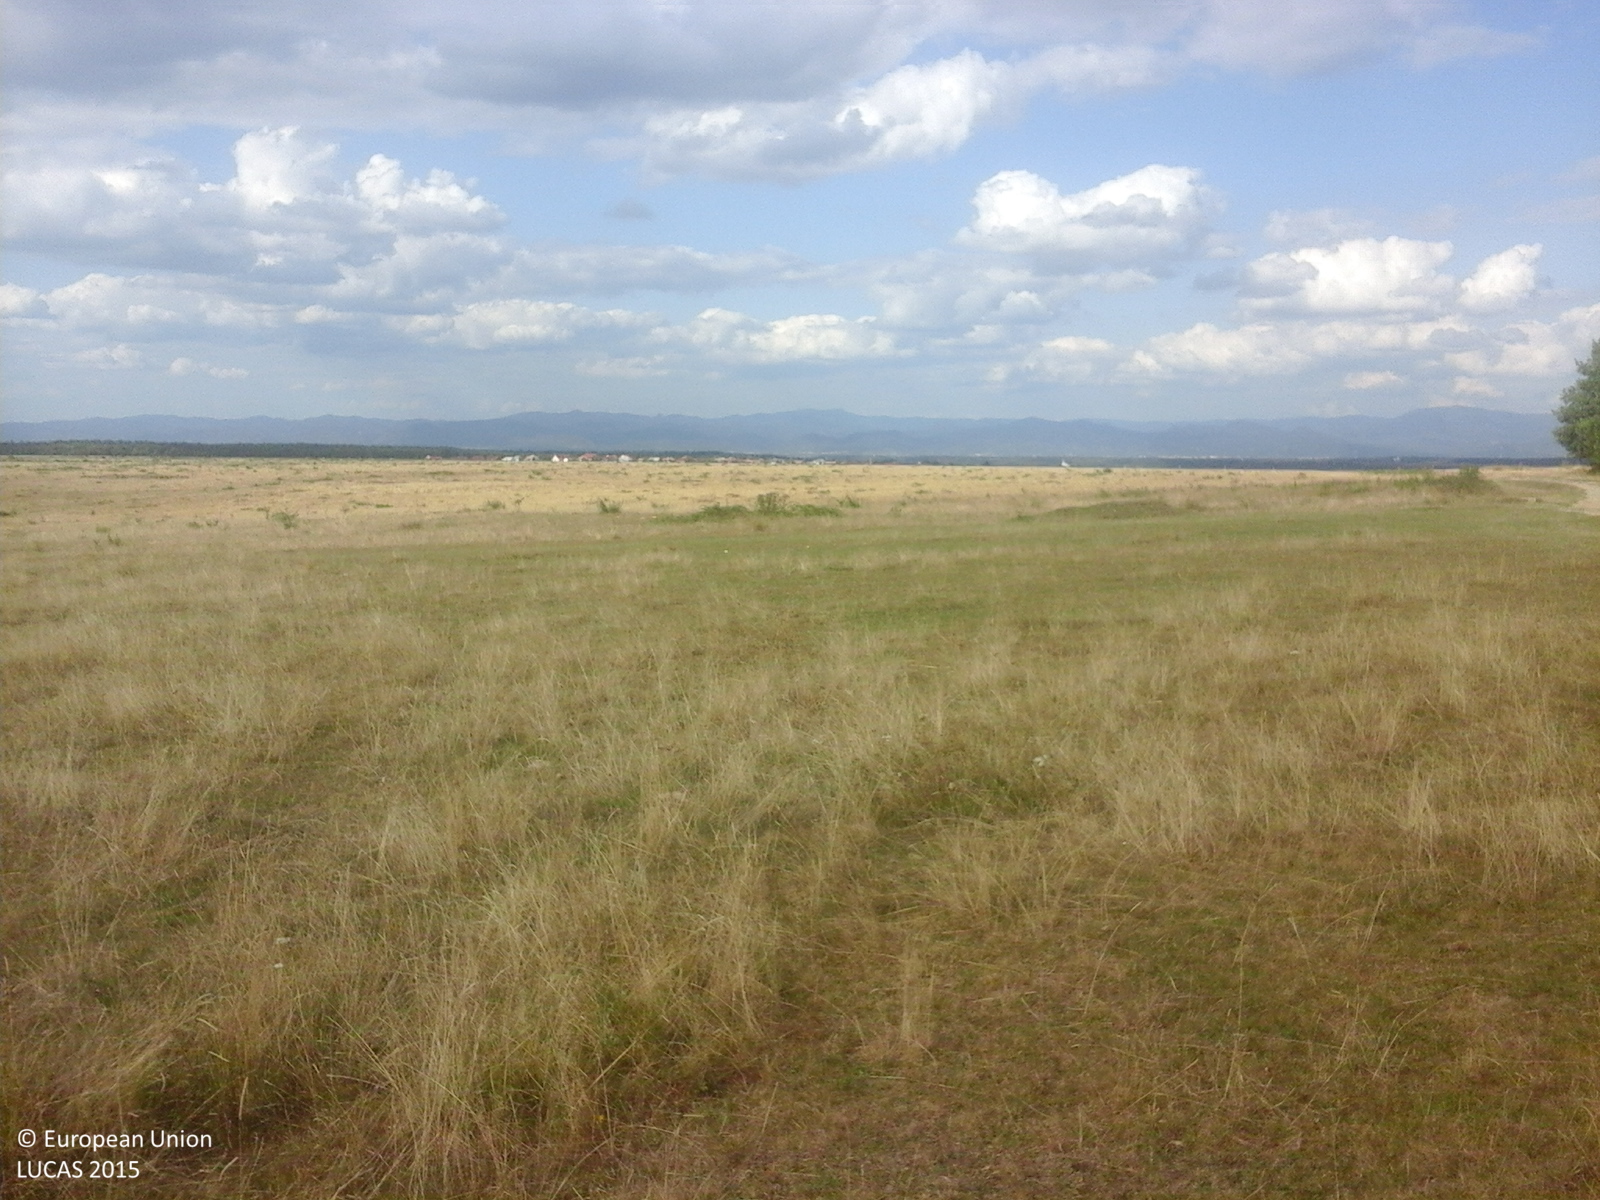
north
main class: Grassland
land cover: Grassland without tree/shrub cover
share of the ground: > 75 %
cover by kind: herbaceous plants 100 %
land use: Agriculture (excluding fallow land and kitchen gardens)
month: September
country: RO
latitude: 47.4874
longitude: 23.4376
